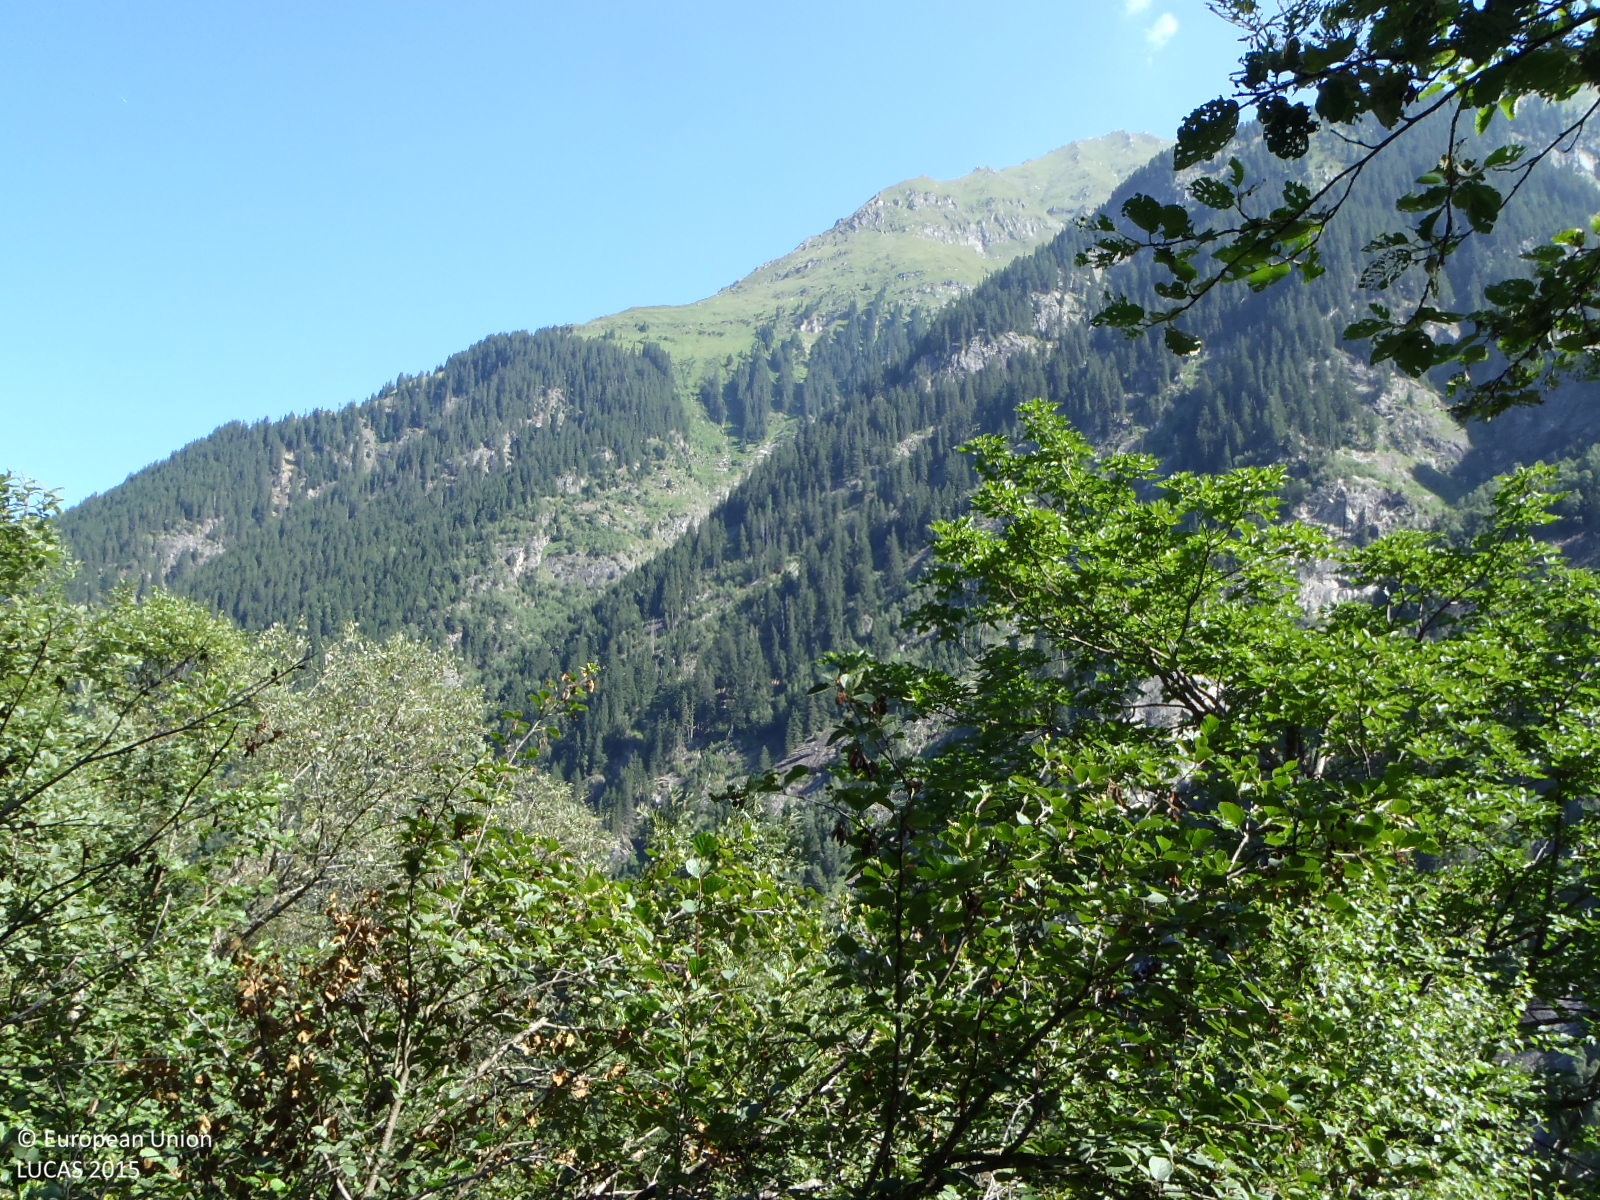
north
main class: Woodland
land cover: Broadleaved woodland
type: mountainous beech forest
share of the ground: > 75 %
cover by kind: broadleaved forest trees 70 %, herbaceous plants 20 %, shrubs 10 %
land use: Forestry
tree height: > 5 m
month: July
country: AT
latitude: 47.0921
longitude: 11.8294
